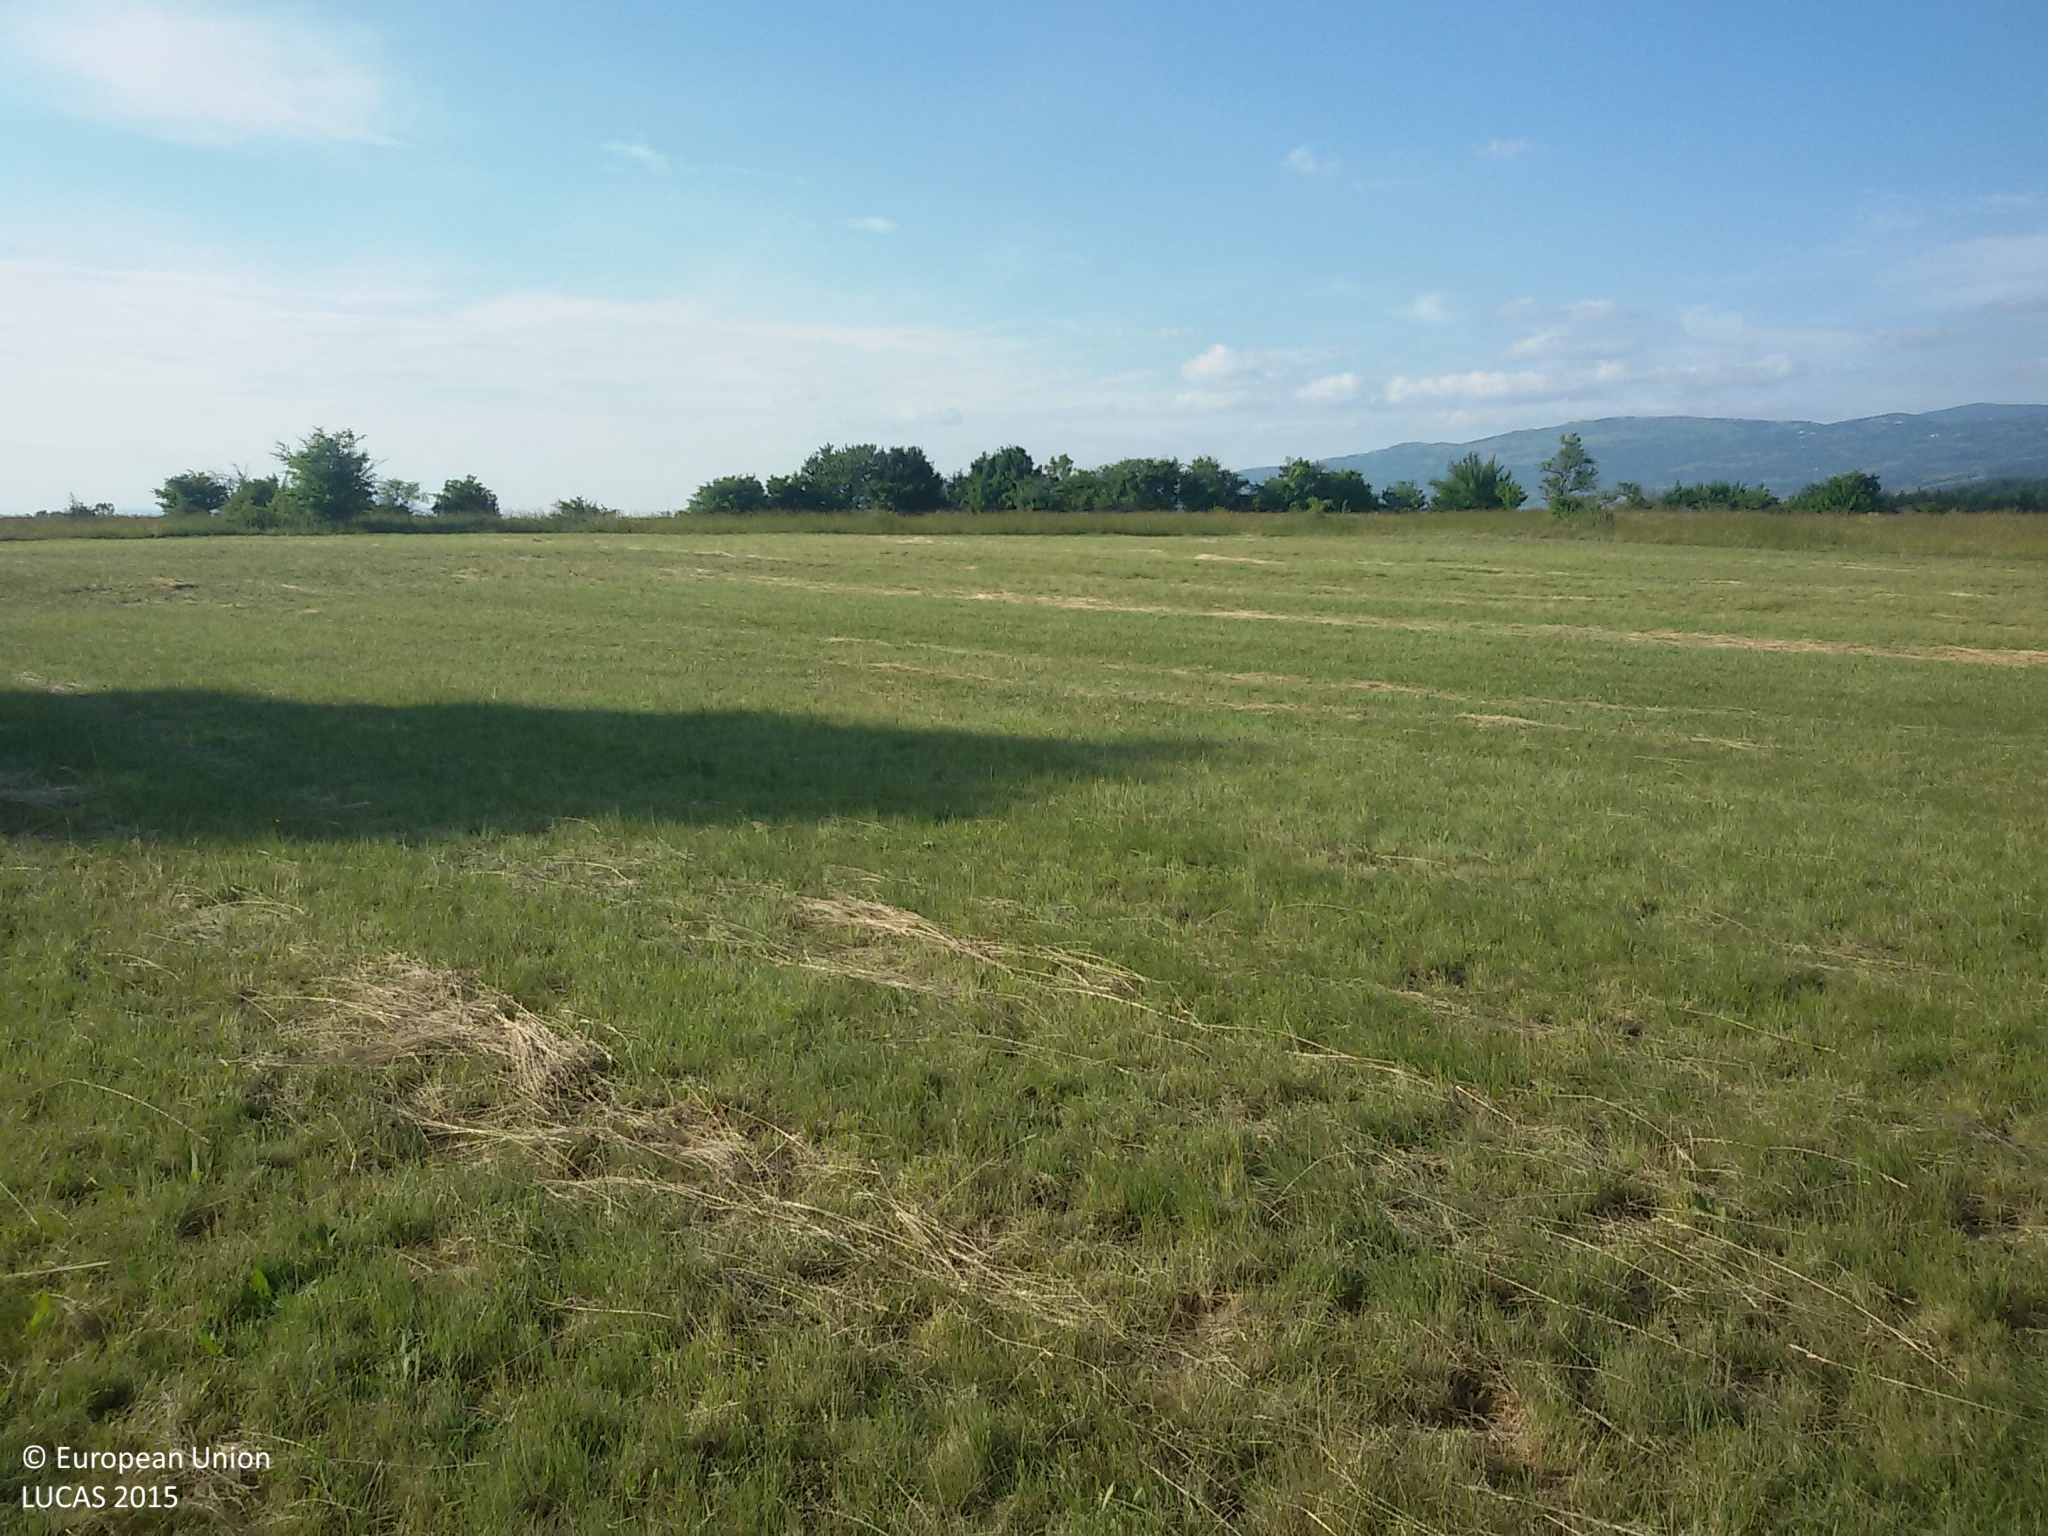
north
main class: Grassland
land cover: Grassland without tree/shrub cover
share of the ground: > 75 %
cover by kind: herbaceous plants 95 %, unconsolidated bare surface 5 %
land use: Agriculture (excluding fallow land and kitchen gardens)
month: June
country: HR
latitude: 44.5169
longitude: 15.7429
